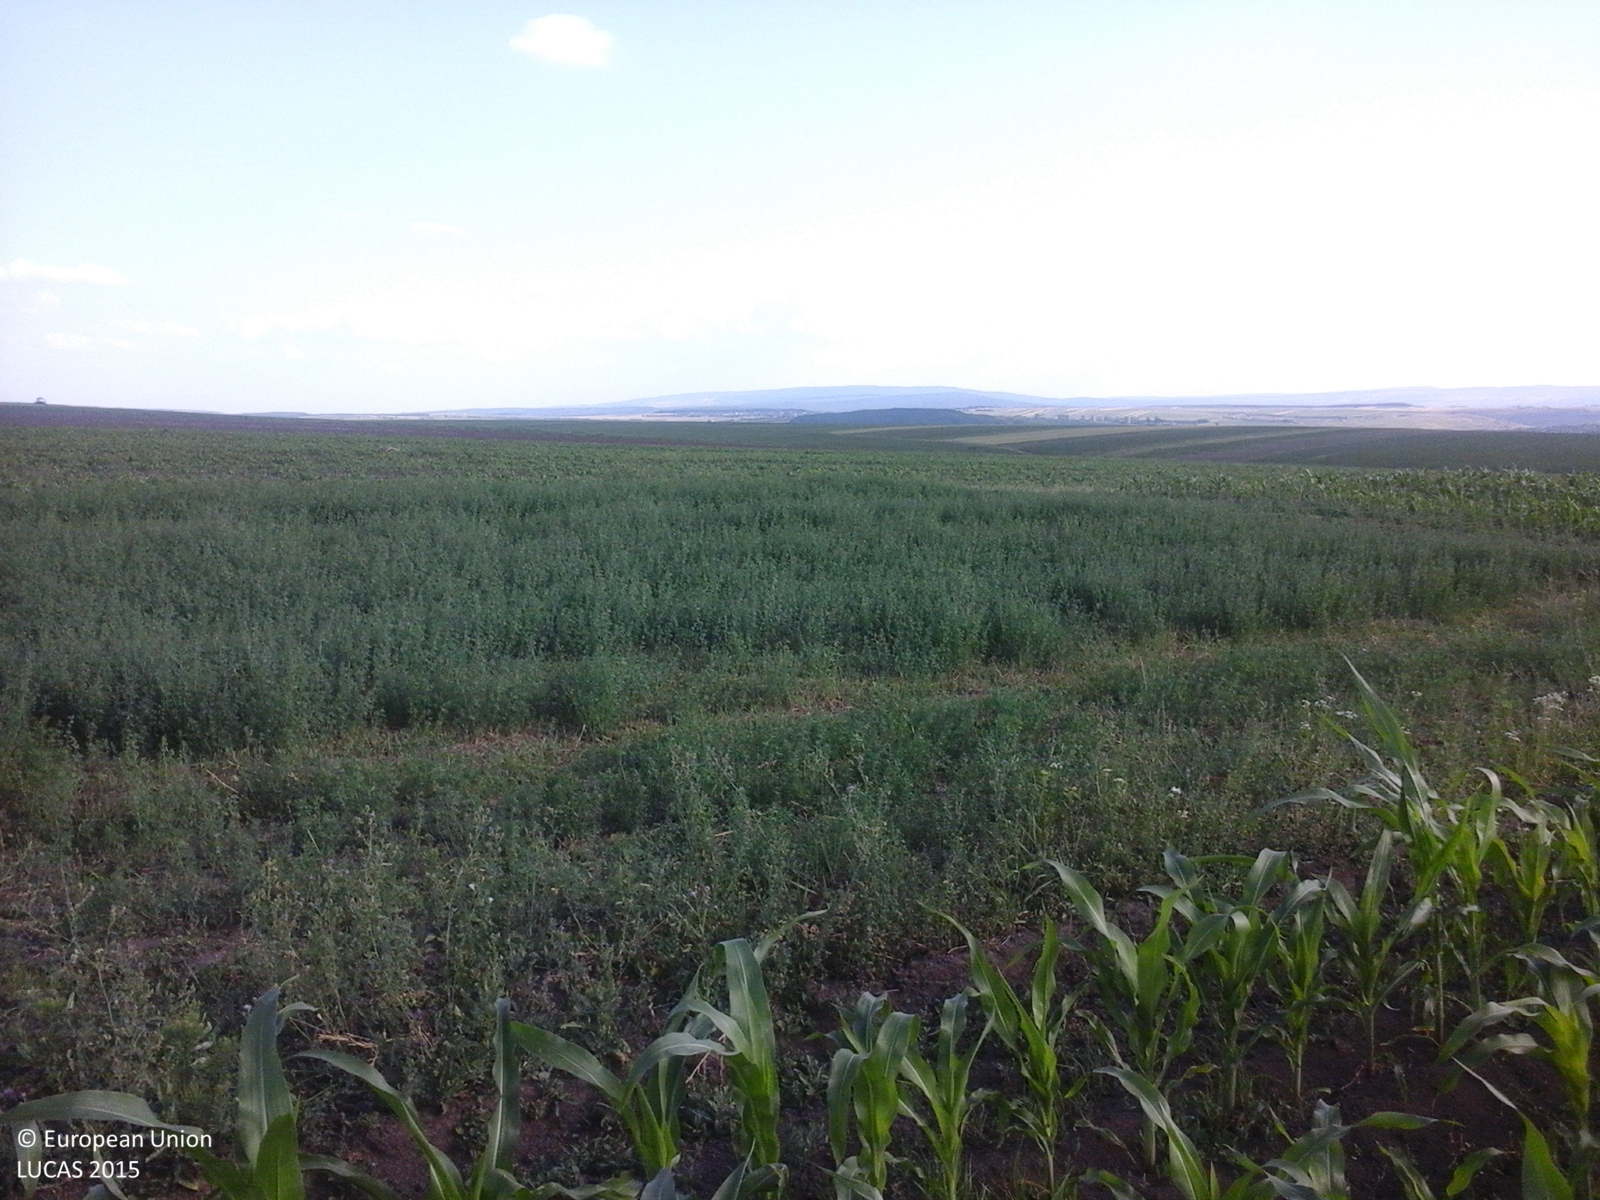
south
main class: Cropland
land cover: Maize
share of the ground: 25 - 50 %
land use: Agriculture (excluding fallow land and kitchen gardens)
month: June
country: RO
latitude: 47.7081
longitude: 26.8259
